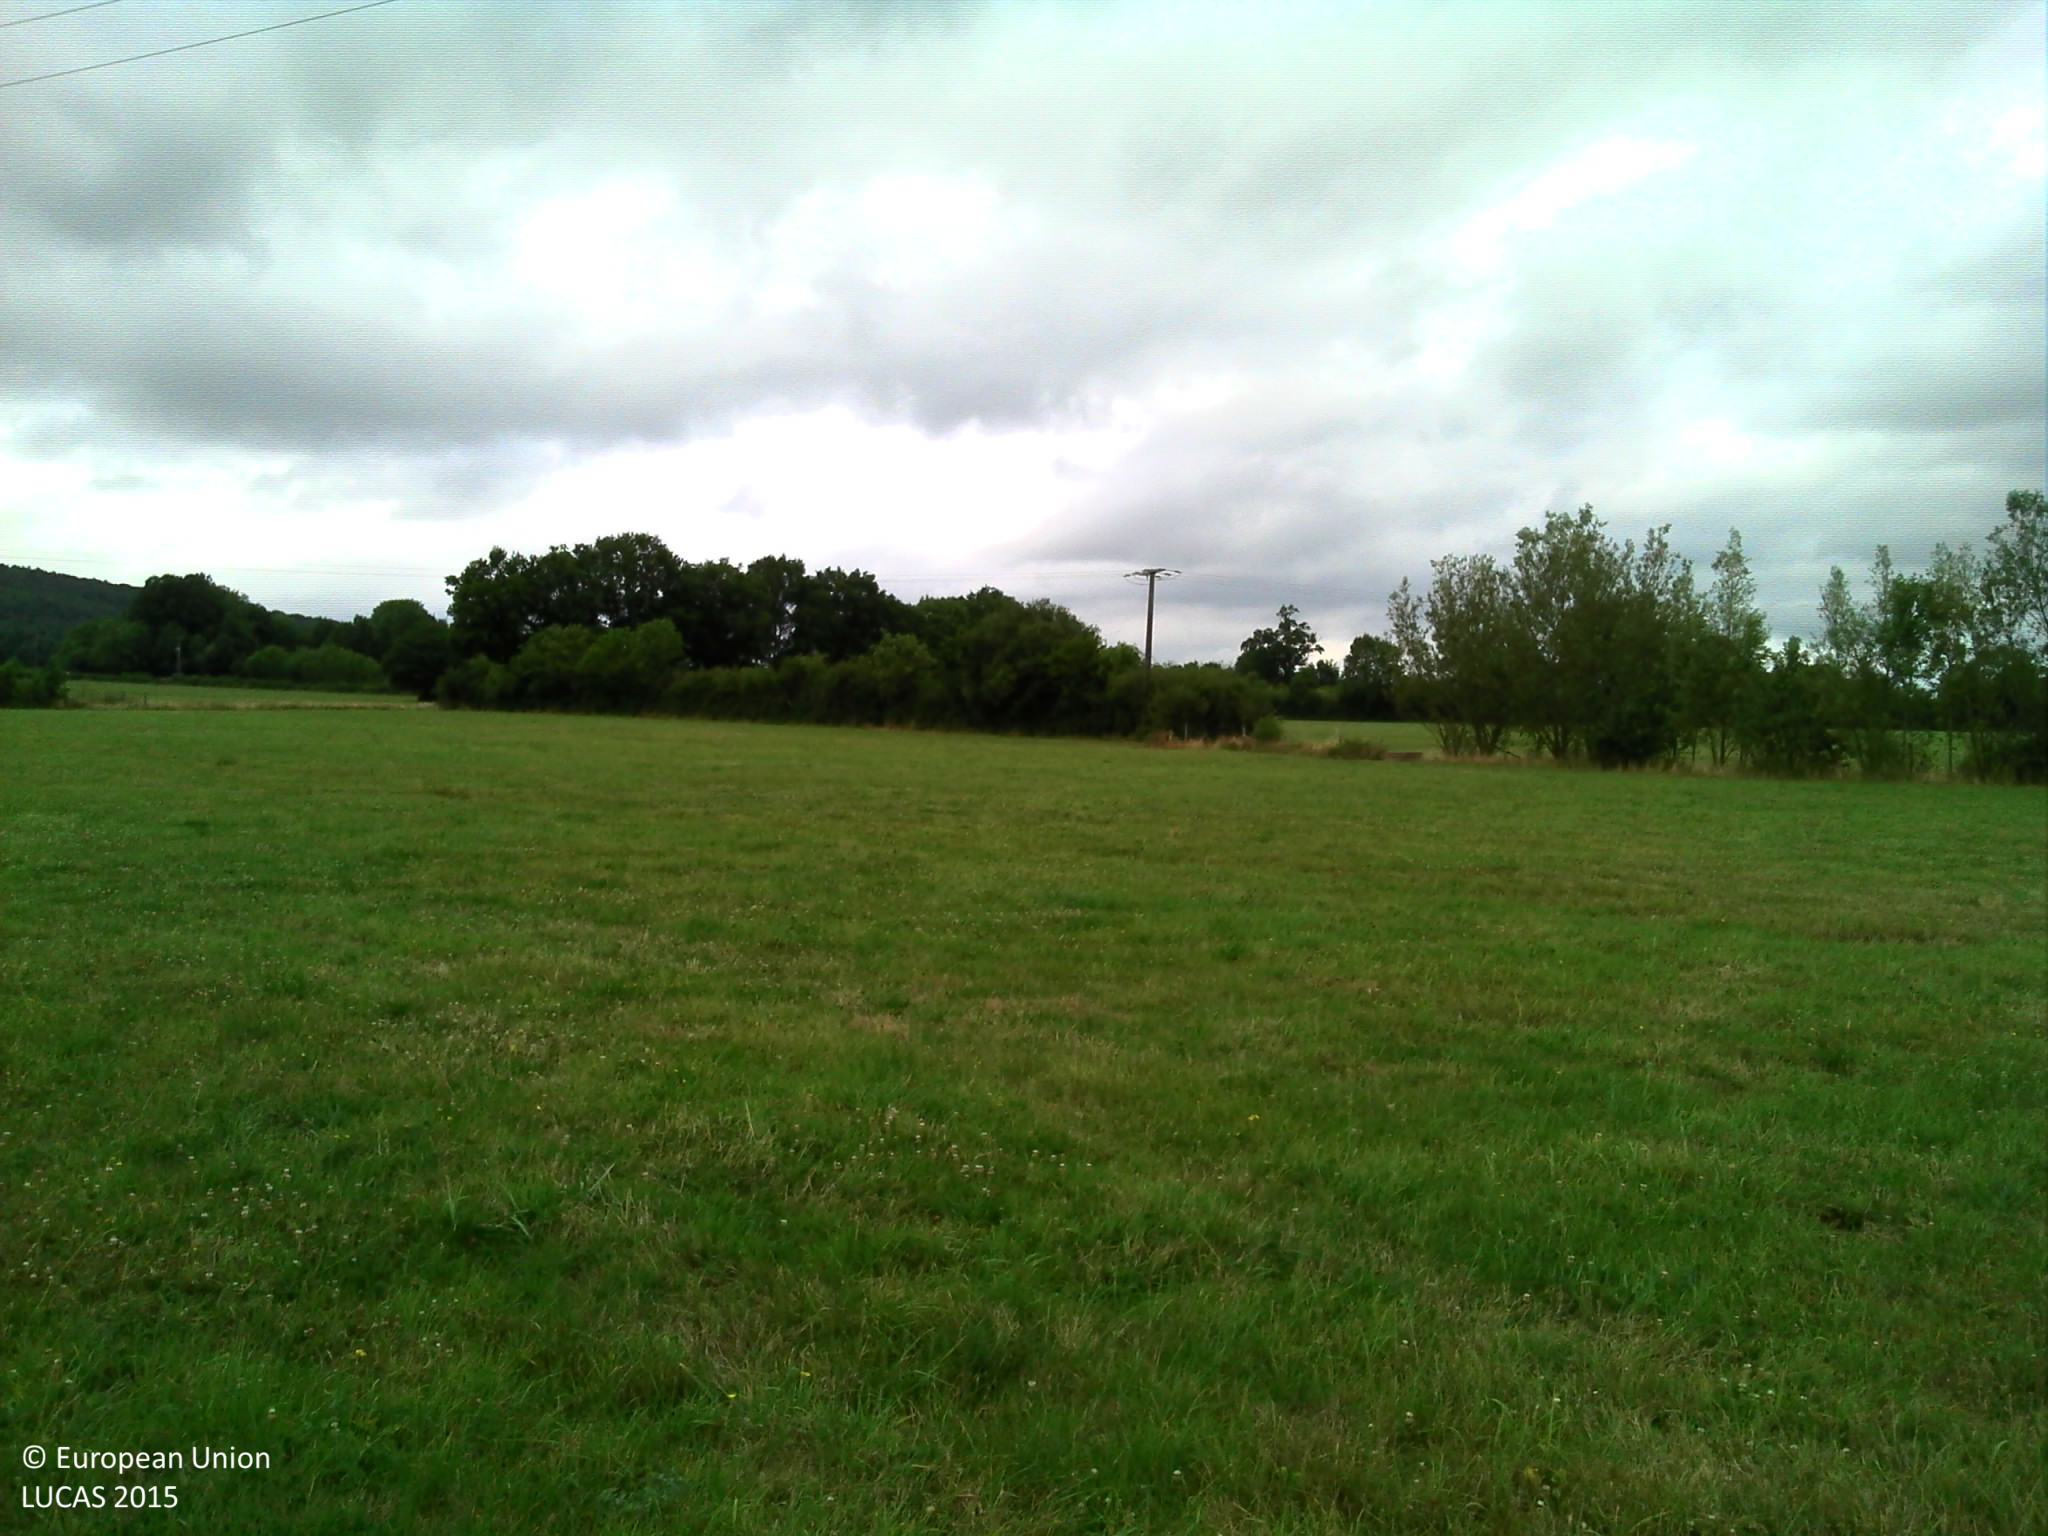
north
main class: Grassland
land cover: Grassland without tree/shrub cover
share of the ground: > 75 %
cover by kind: herbaceous plants 100 %
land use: Agriculture (excluding fallow land and kitchen gardens)
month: July
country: FR
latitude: 48.4320
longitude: -0.0722
